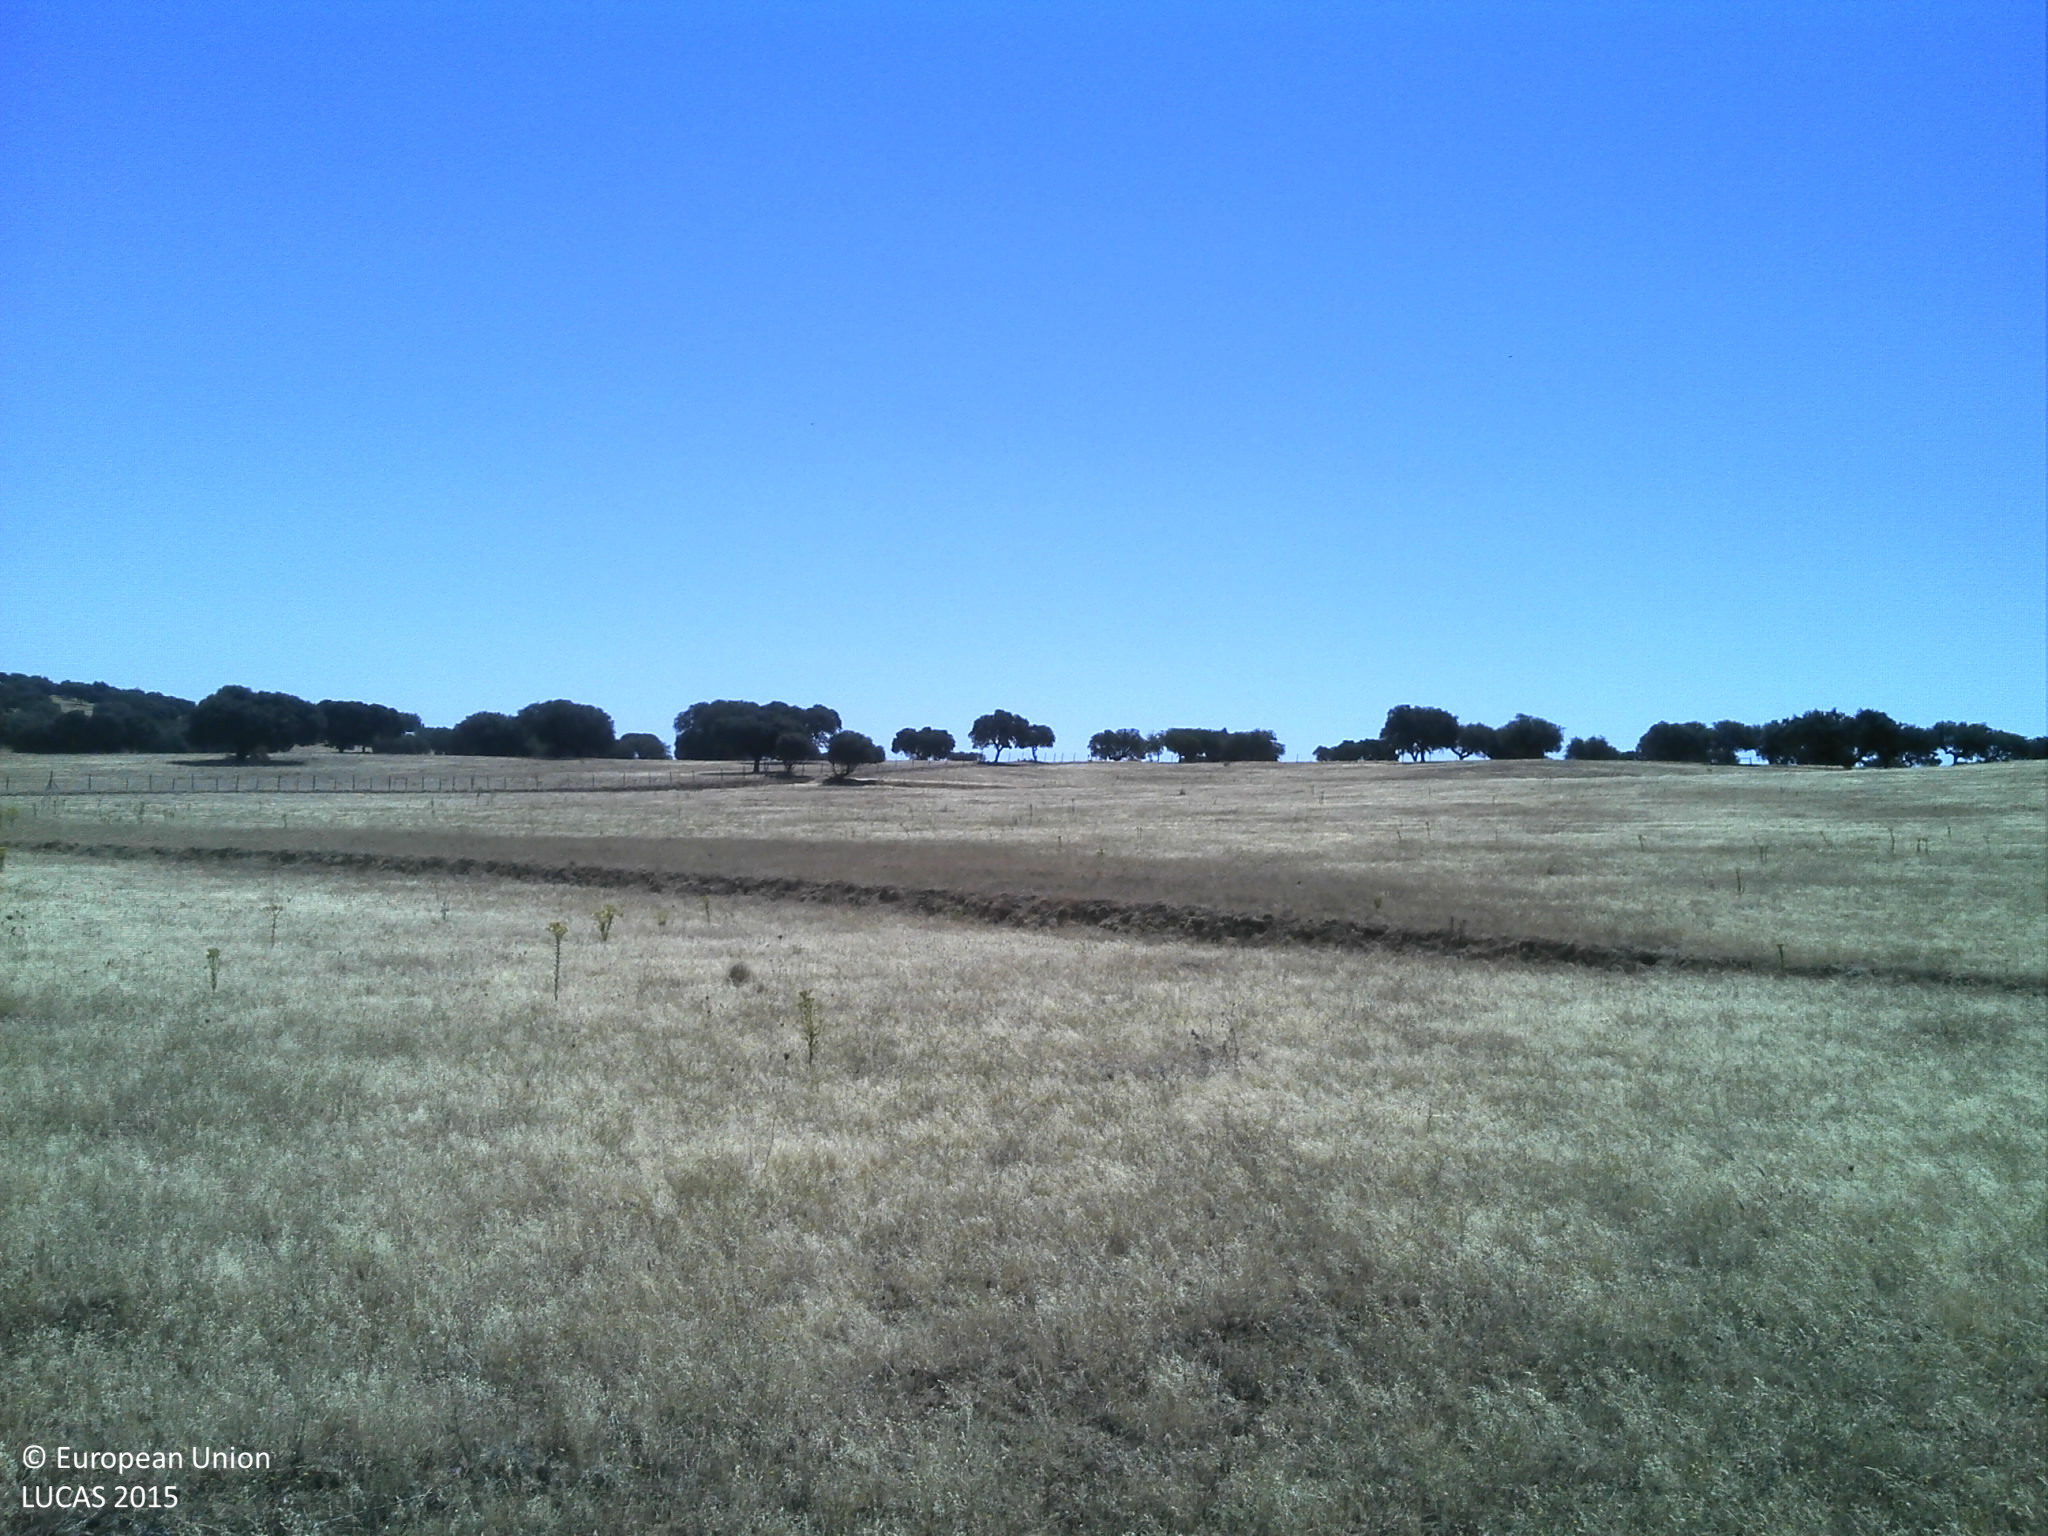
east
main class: Grassland
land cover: Spontaneously vegetated surfaces
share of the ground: 10 - 25 %
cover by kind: unconsolidated bare surface 85 %, herbaceous plants 15 %
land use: Fallow land
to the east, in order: Spontaneously vegetated surfaces; Rivers and streams; Other bare soil; Fences; Other bare soil; Grassland without tree/shrub cover; Broadleaved woodland
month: July
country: PT
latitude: 39.0534
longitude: -7.0732
